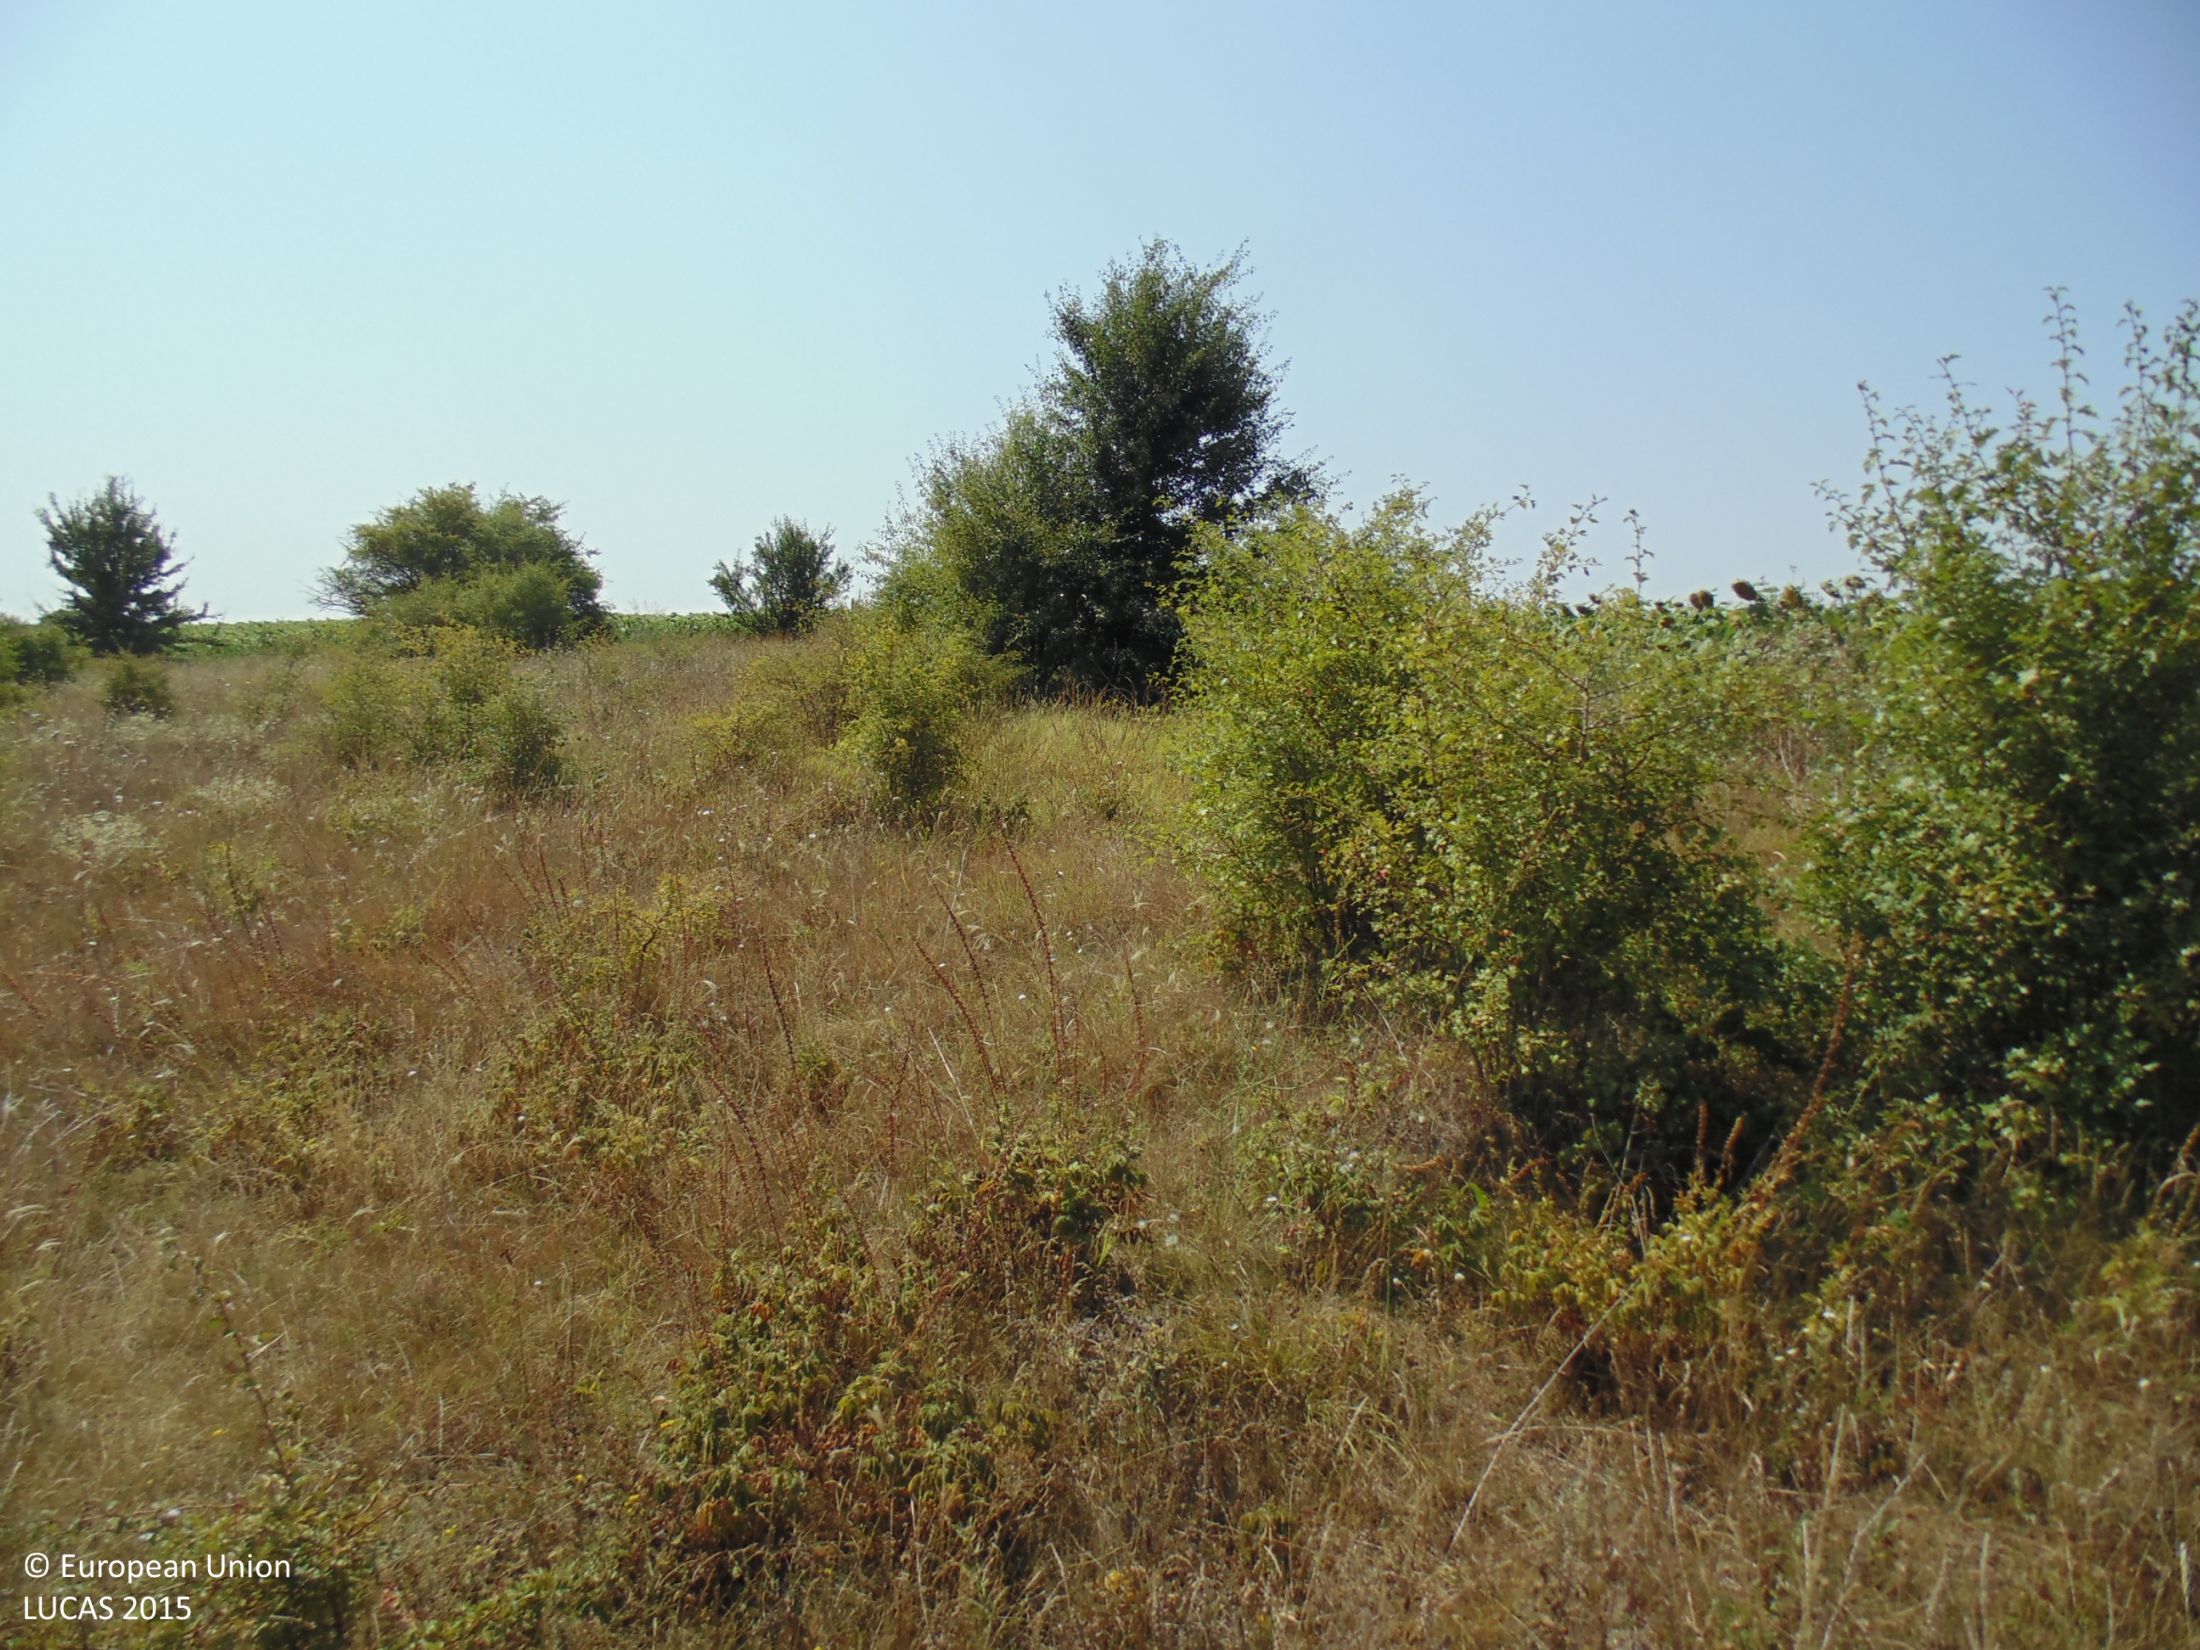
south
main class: Grassland
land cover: Grassland with sparse tree/shrub cover
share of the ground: > 75 %
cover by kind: herbaceous plants 90 %, broadleaved forest trees 5 %, shrubs 5 %
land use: Agriculture (excluding fallow land and kitchen gardens)
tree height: < 5 m
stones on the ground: < 10 %
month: August
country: BG
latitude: 43.9819
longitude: 27.5550
